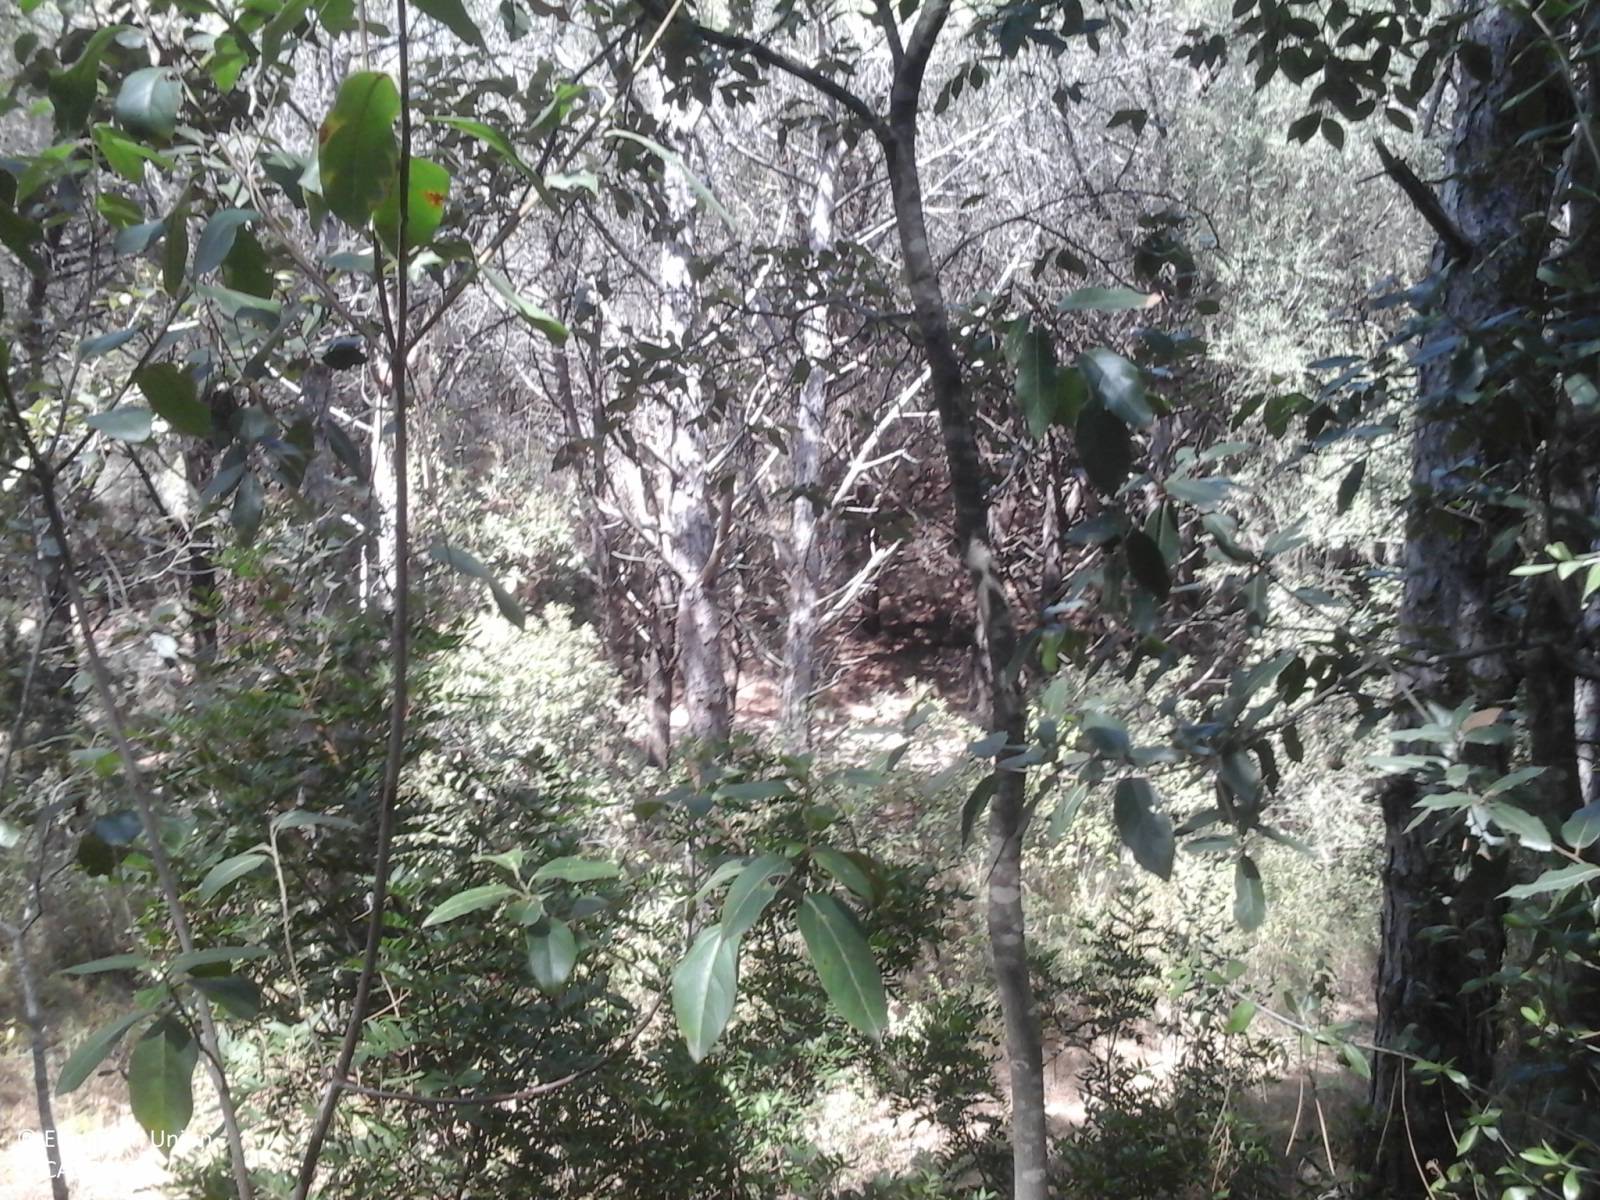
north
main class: Woodland
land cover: Pine dominated coniferous woodland
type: coniferous forest of the mediterranean region
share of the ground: 10 - 25 %
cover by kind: herbaceous plants 60 %, shrubs 30 %, coniferous forest trees 10 %
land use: Semi-natural and natural areas not in use
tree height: > 5 m
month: July
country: IT
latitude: 41.1686
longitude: 9.1813
